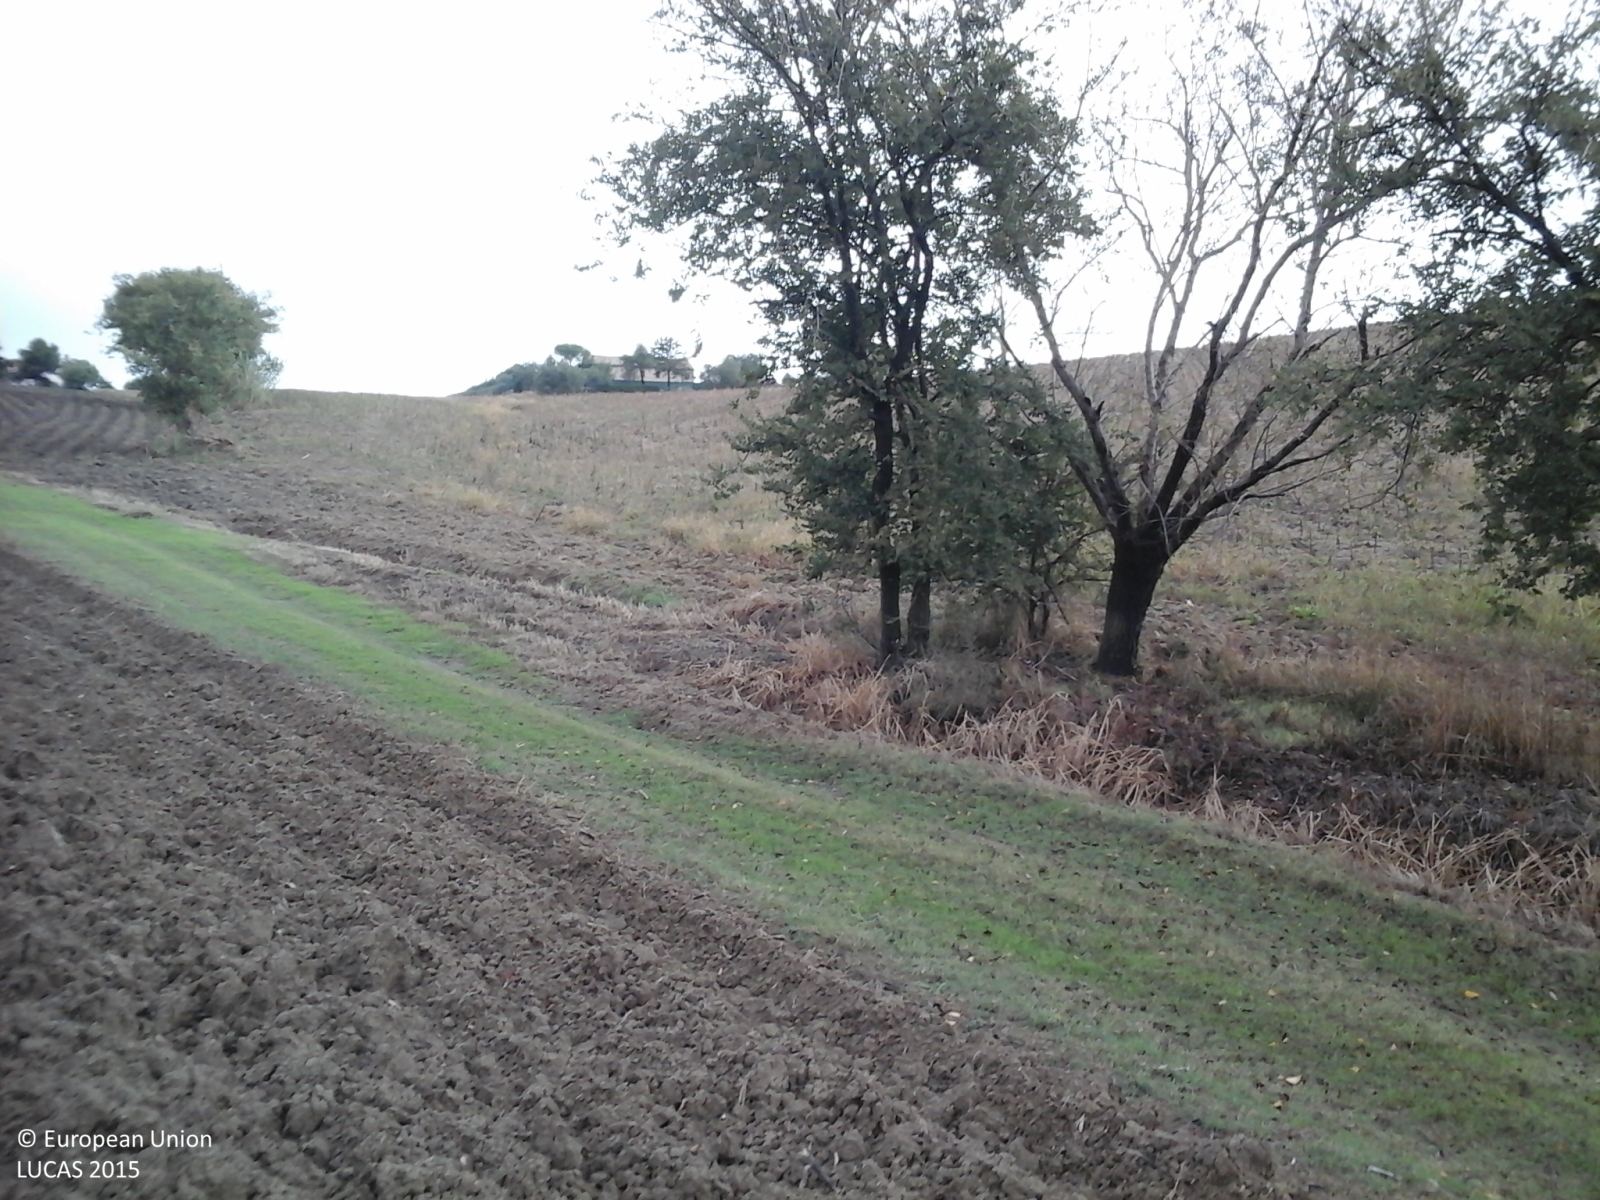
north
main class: Cropland
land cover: Sunflower
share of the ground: < 10 %
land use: Agriculture (excluding fallow land and kitchen gardens)
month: October
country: IT
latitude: 43.6865
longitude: 13.2302
